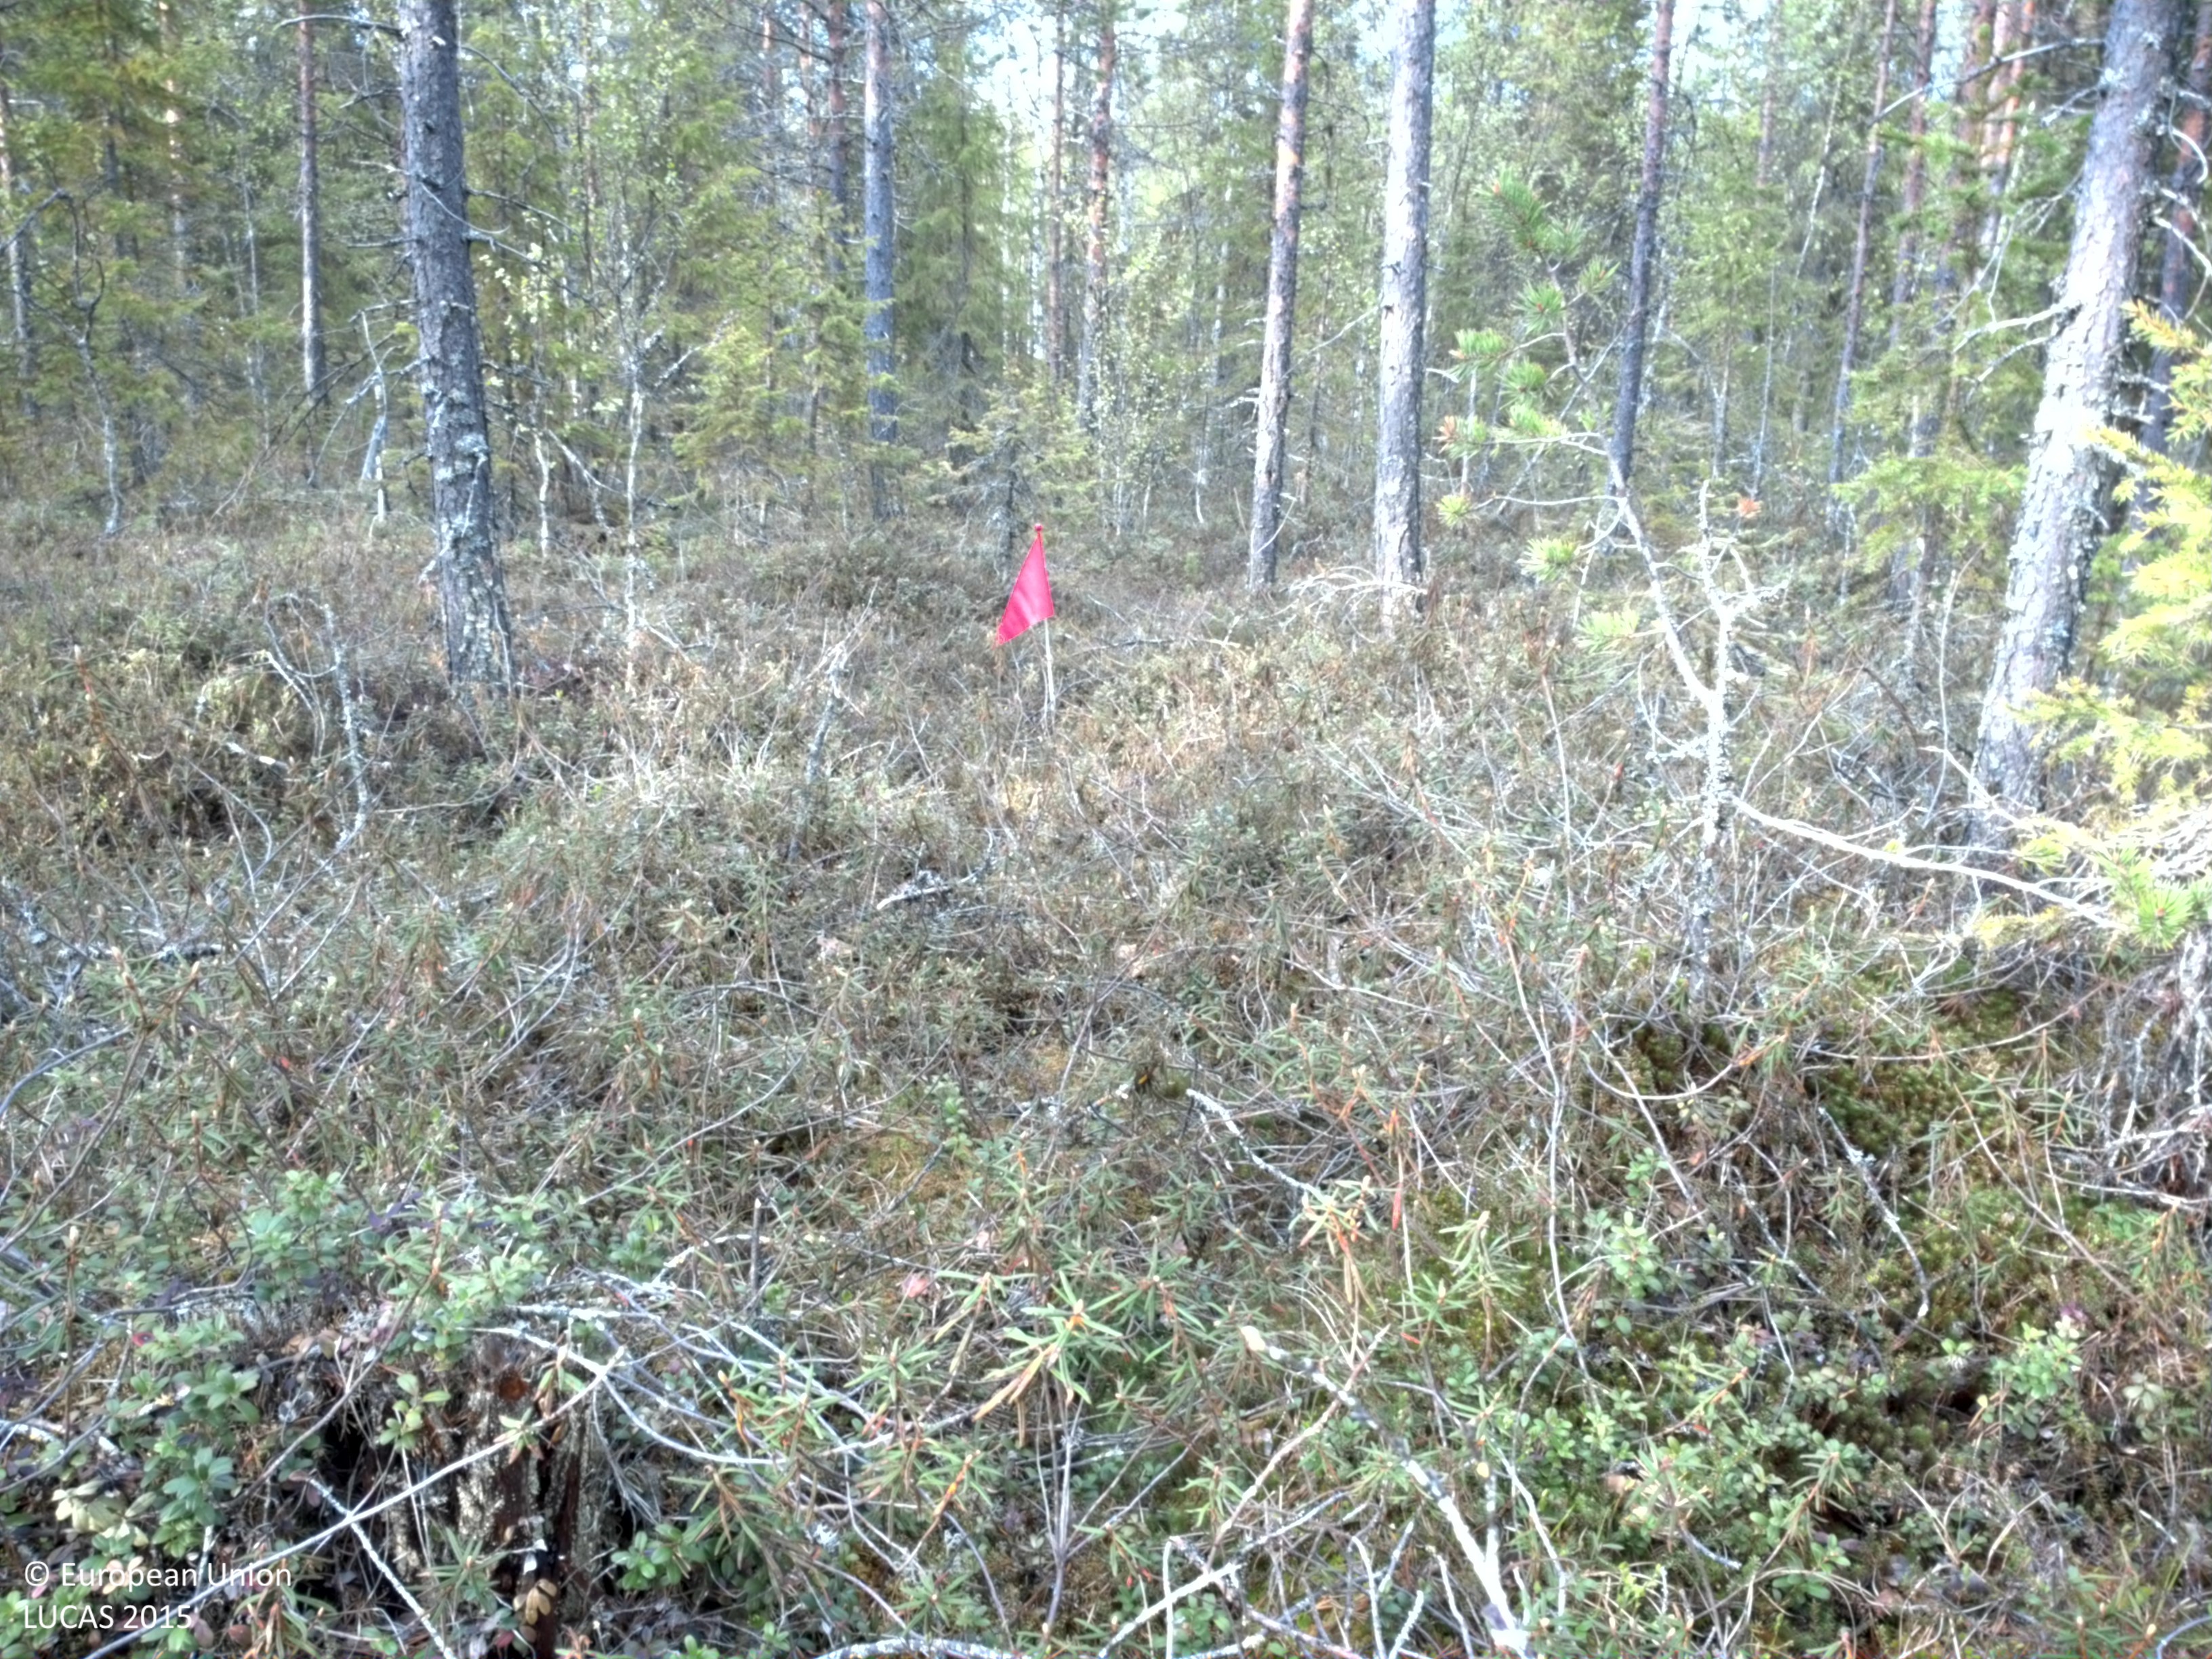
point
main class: Woodland
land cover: Pine dominated coniferous woodland
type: boreal forest
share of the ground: 50 - 75 %
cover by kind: coniferous forest trees 55 %, shrubs 40 %, broadleaved forest trees 5 %
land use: Forestry
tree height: > 5 m
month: June
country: SE
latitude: 66.4757
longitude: 22.9318
